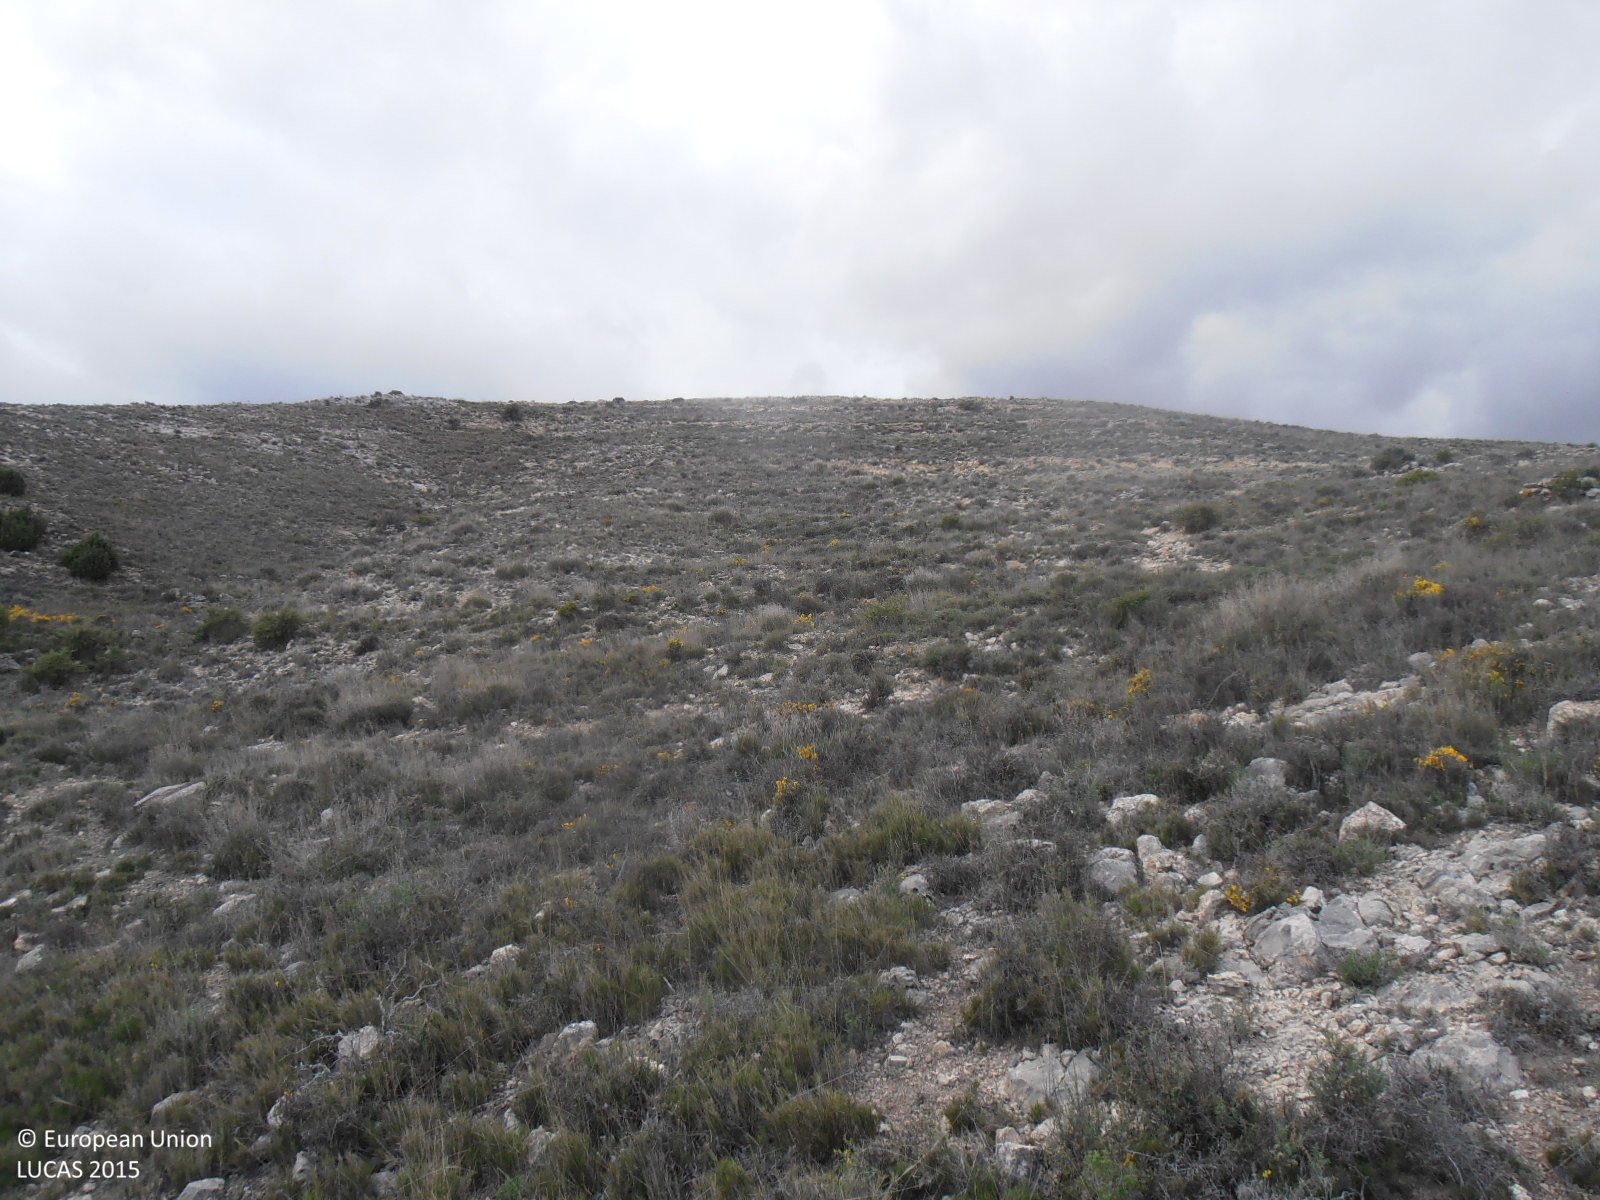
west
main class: Shrubland
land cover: Shrubland without tree cover
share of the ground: 50 - 75 %
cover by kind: shrubs 50 %, consolidated bare surface 40 %, herbaceous plants 10 %
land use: Semi-natural and natural areas not in use
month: April
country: ES
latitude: 41.1563
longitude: -0.7052
